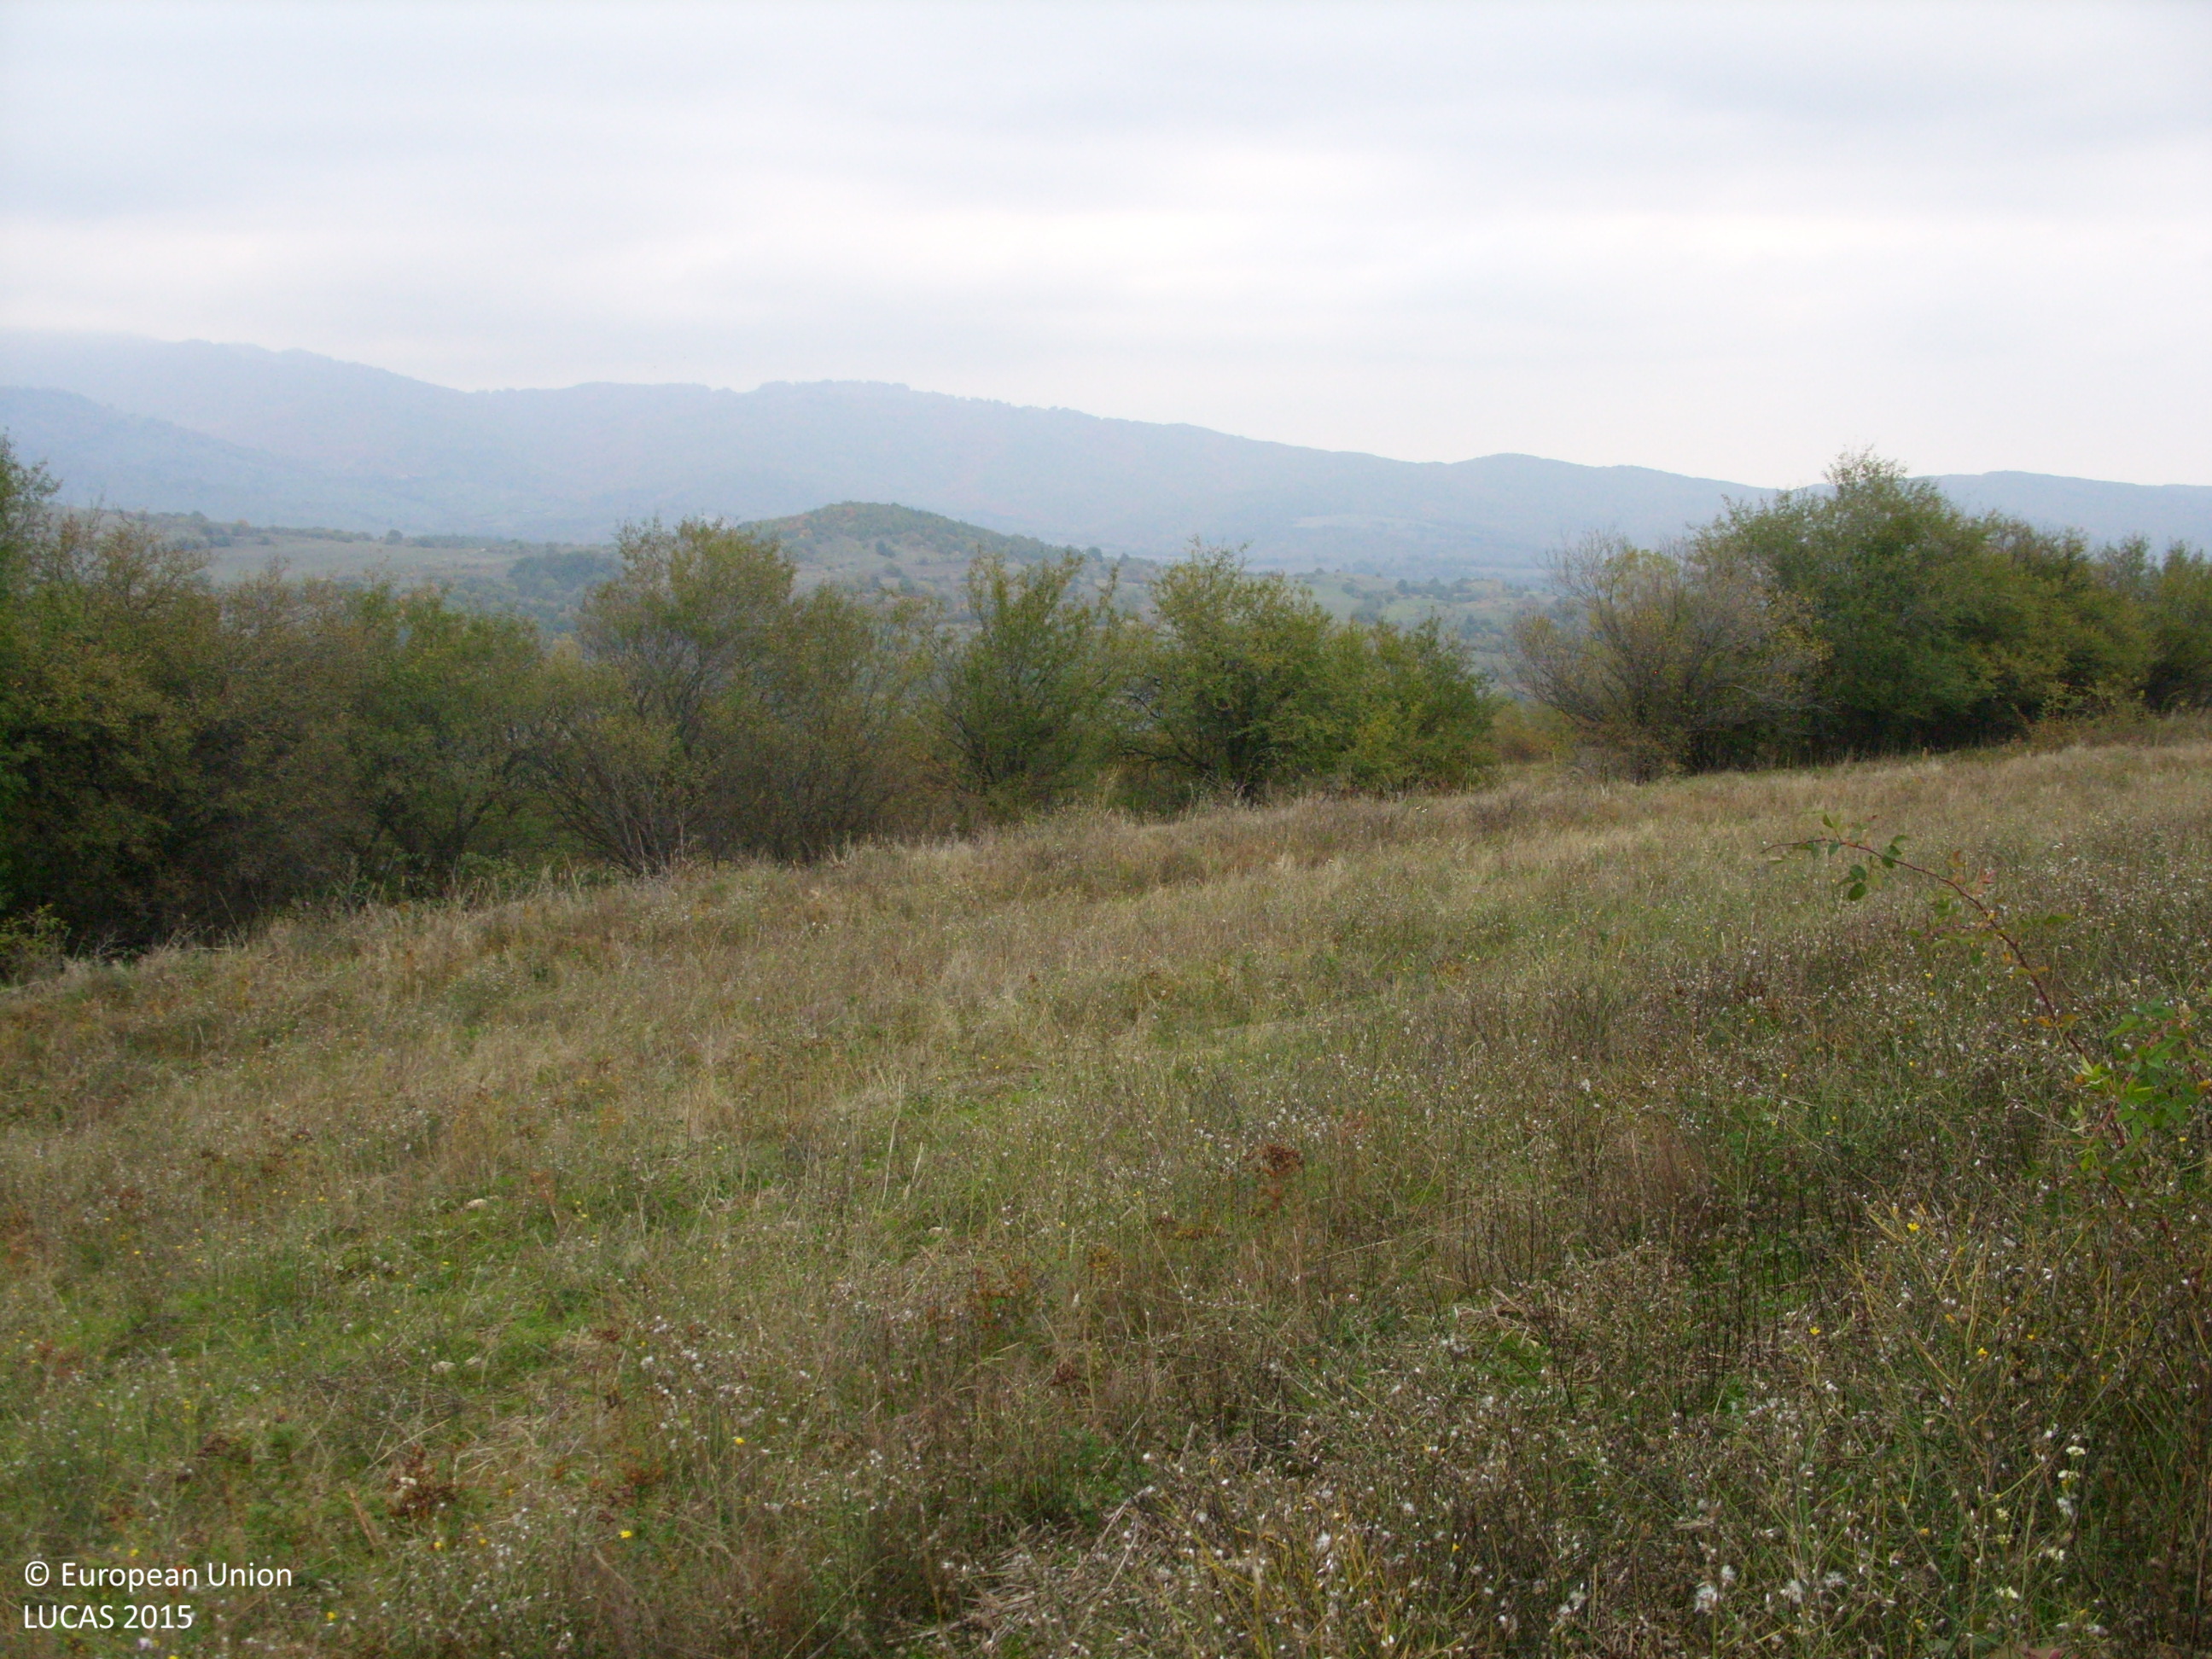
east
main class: Grassland
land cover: Spontaneously vegetated surfaces
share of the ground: > 75 %
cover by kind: herbaceous plants 100 %
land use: Agriculture (excluding fallow land and kitchen gardens)
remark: Harvested field
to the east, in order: Spontaneously vegetated surfaces; Broadleaved woodland; Spontaneously vegetated surfaces; Broadleaved woodland; Ditches and canals; Paved roads, cycling and walking lanes; Ditches and canals; Broadleaved woodland; Spontaneously vegetated surfaces; Grassland with sparse tree/shrub cover; Tracks; Shrubland with sparse tree cover
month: October
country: BG
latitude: 42.5613
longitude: 24.2126
